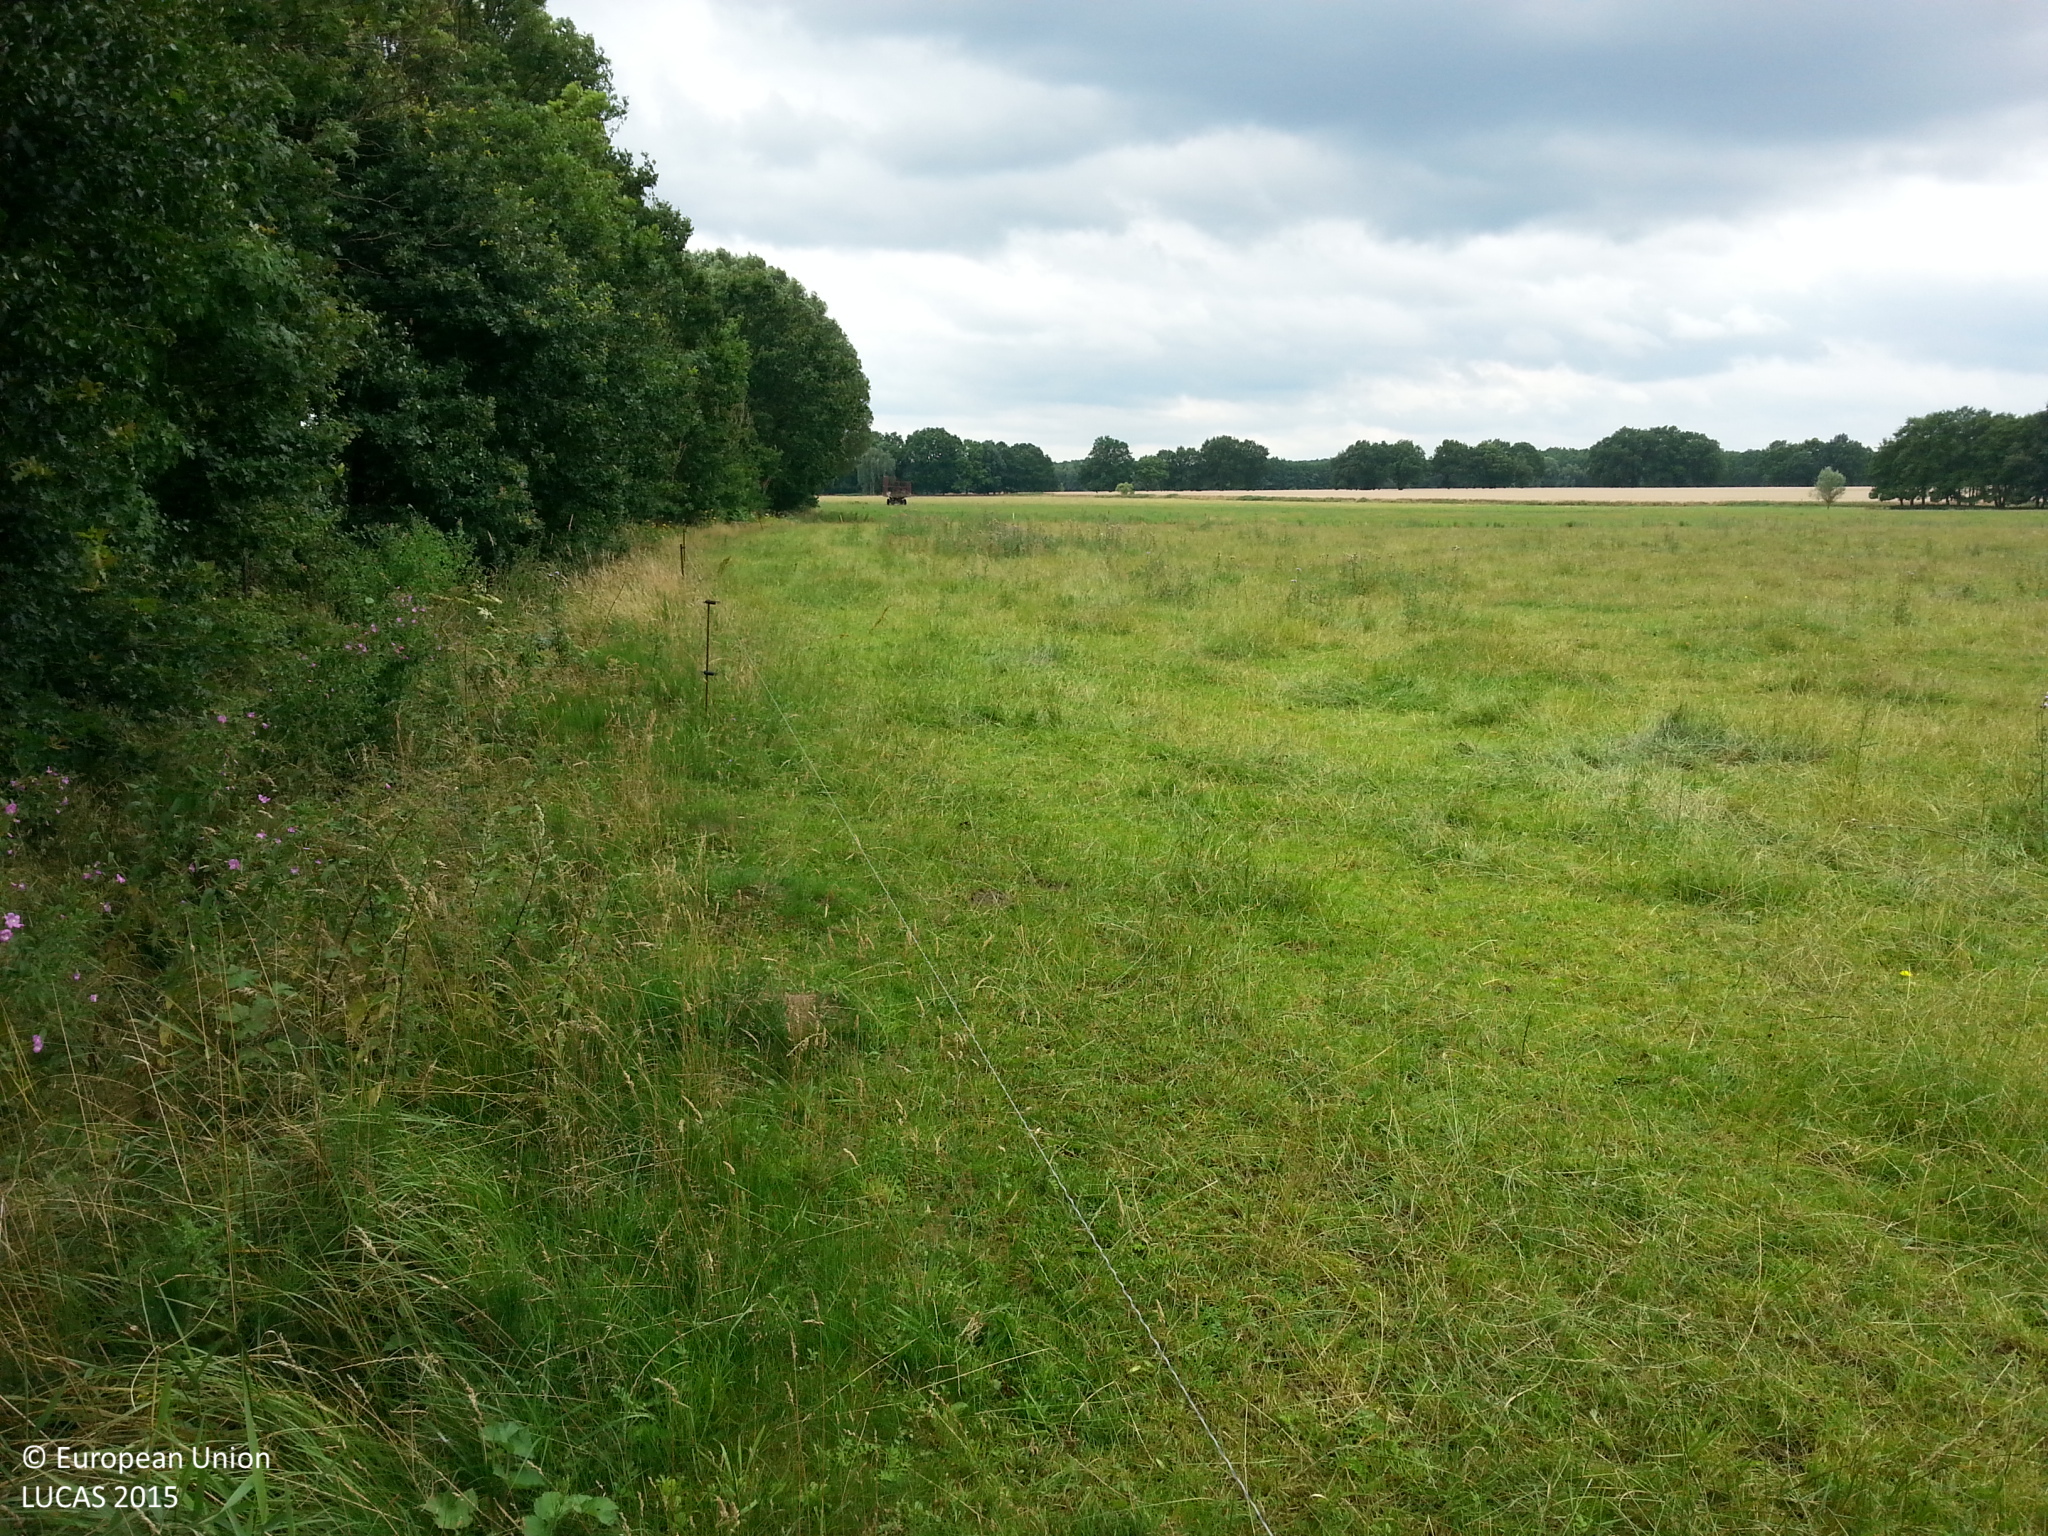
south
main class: Grassland
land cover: Grassland without tree/shrub cover
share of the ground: > 75 %
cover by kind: herbaceous plants 100 %
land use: Agriculture (excluding fallow land and kitchen gardens)
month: July
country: DE
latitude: 53.1994
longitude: 12.3496
